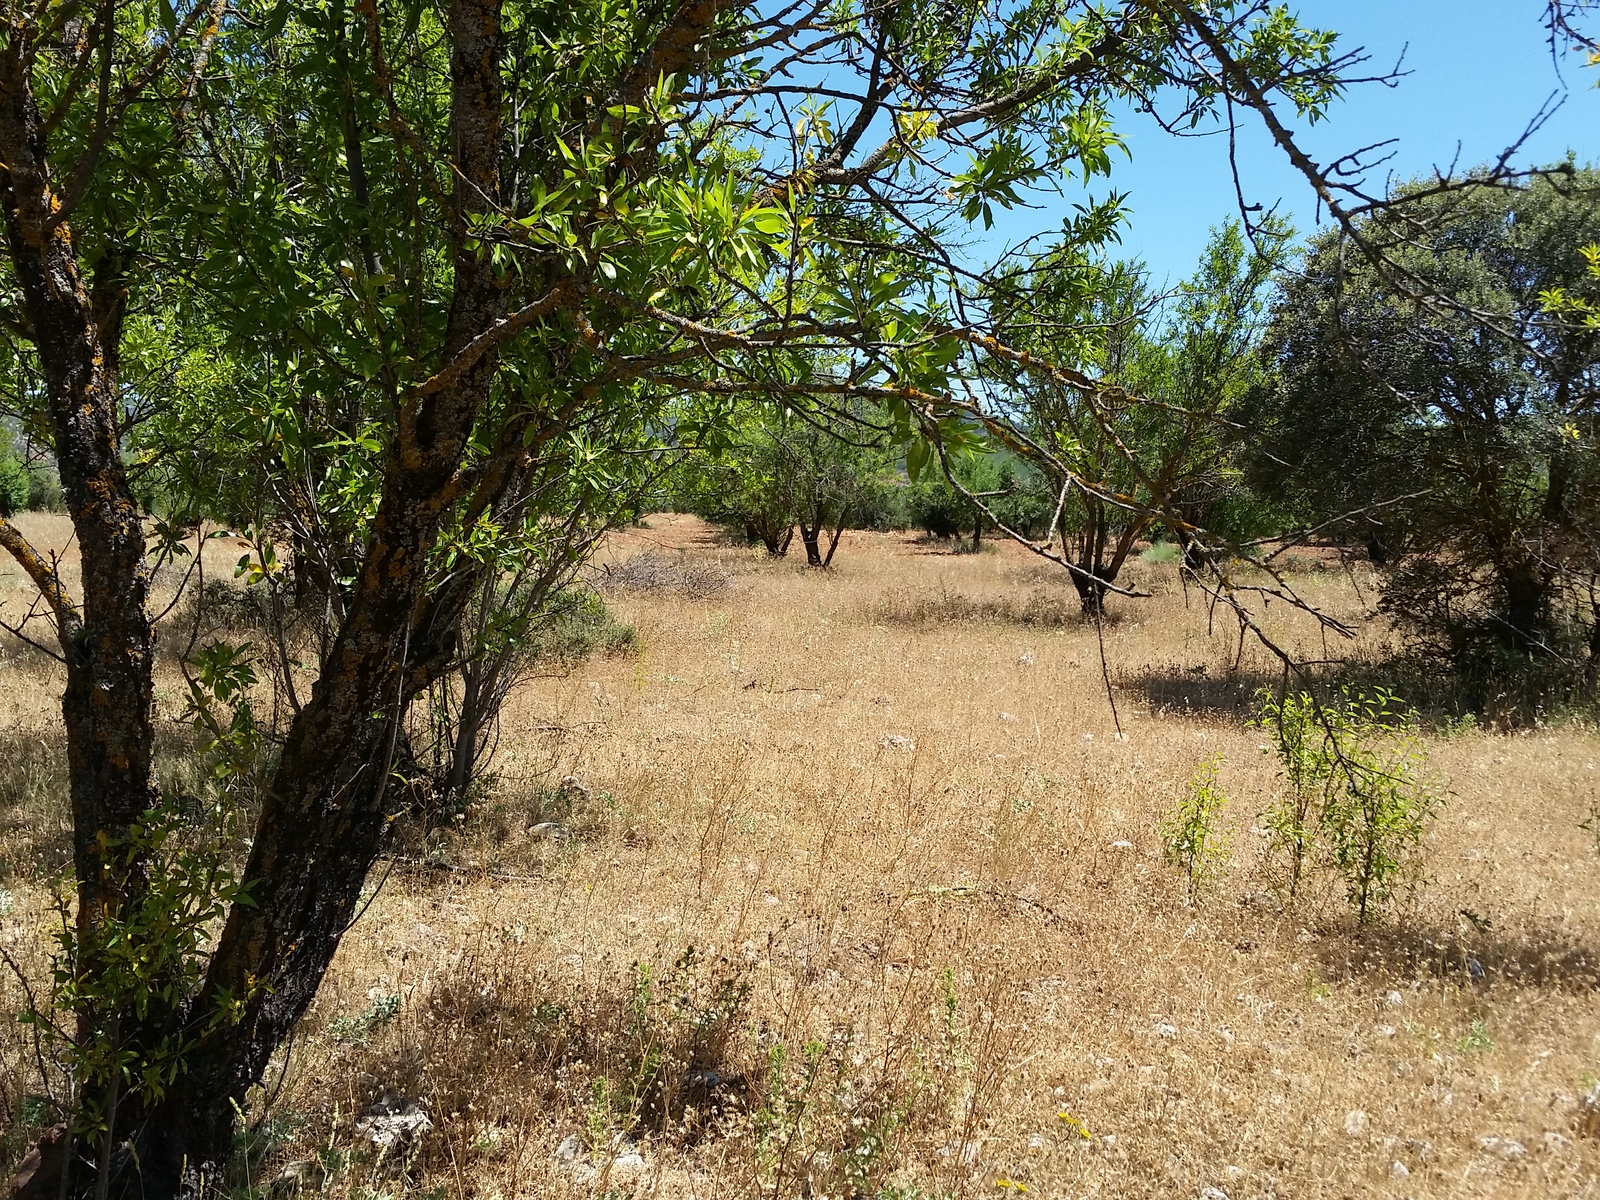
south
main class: Cropland
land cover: Nuts trees
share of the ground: 25 - 50 %
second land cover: Grassland without tree/shrub cover
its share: > 75 %
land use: Agriculture (excluding fallow land and kitchen gardens)
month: June
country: ES
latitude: 38.6307
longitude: -2.5799
